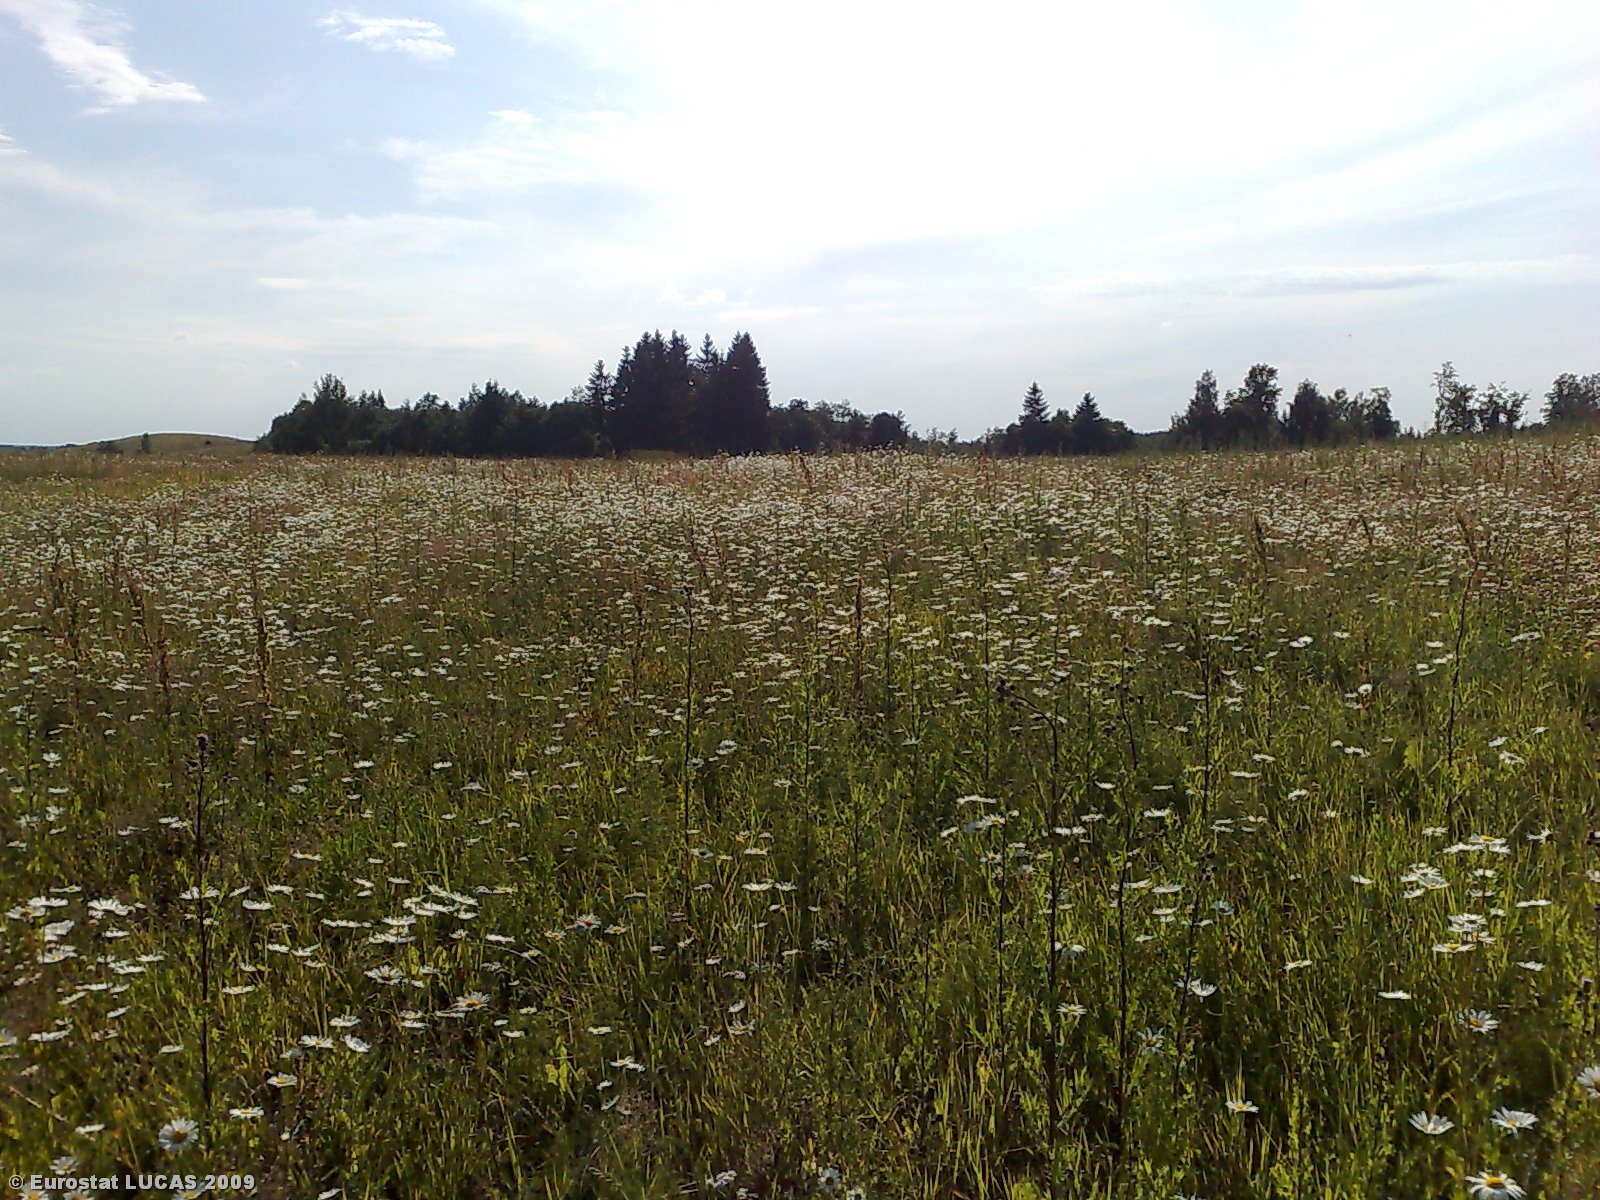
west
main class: Grassland
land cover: Grassland without tree/shrub cover
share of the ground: > 75 %
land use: Agriculture (excluding fallow land and kitchen gardens)
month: July
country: LT
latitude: 55.5328
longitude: 22.7239
